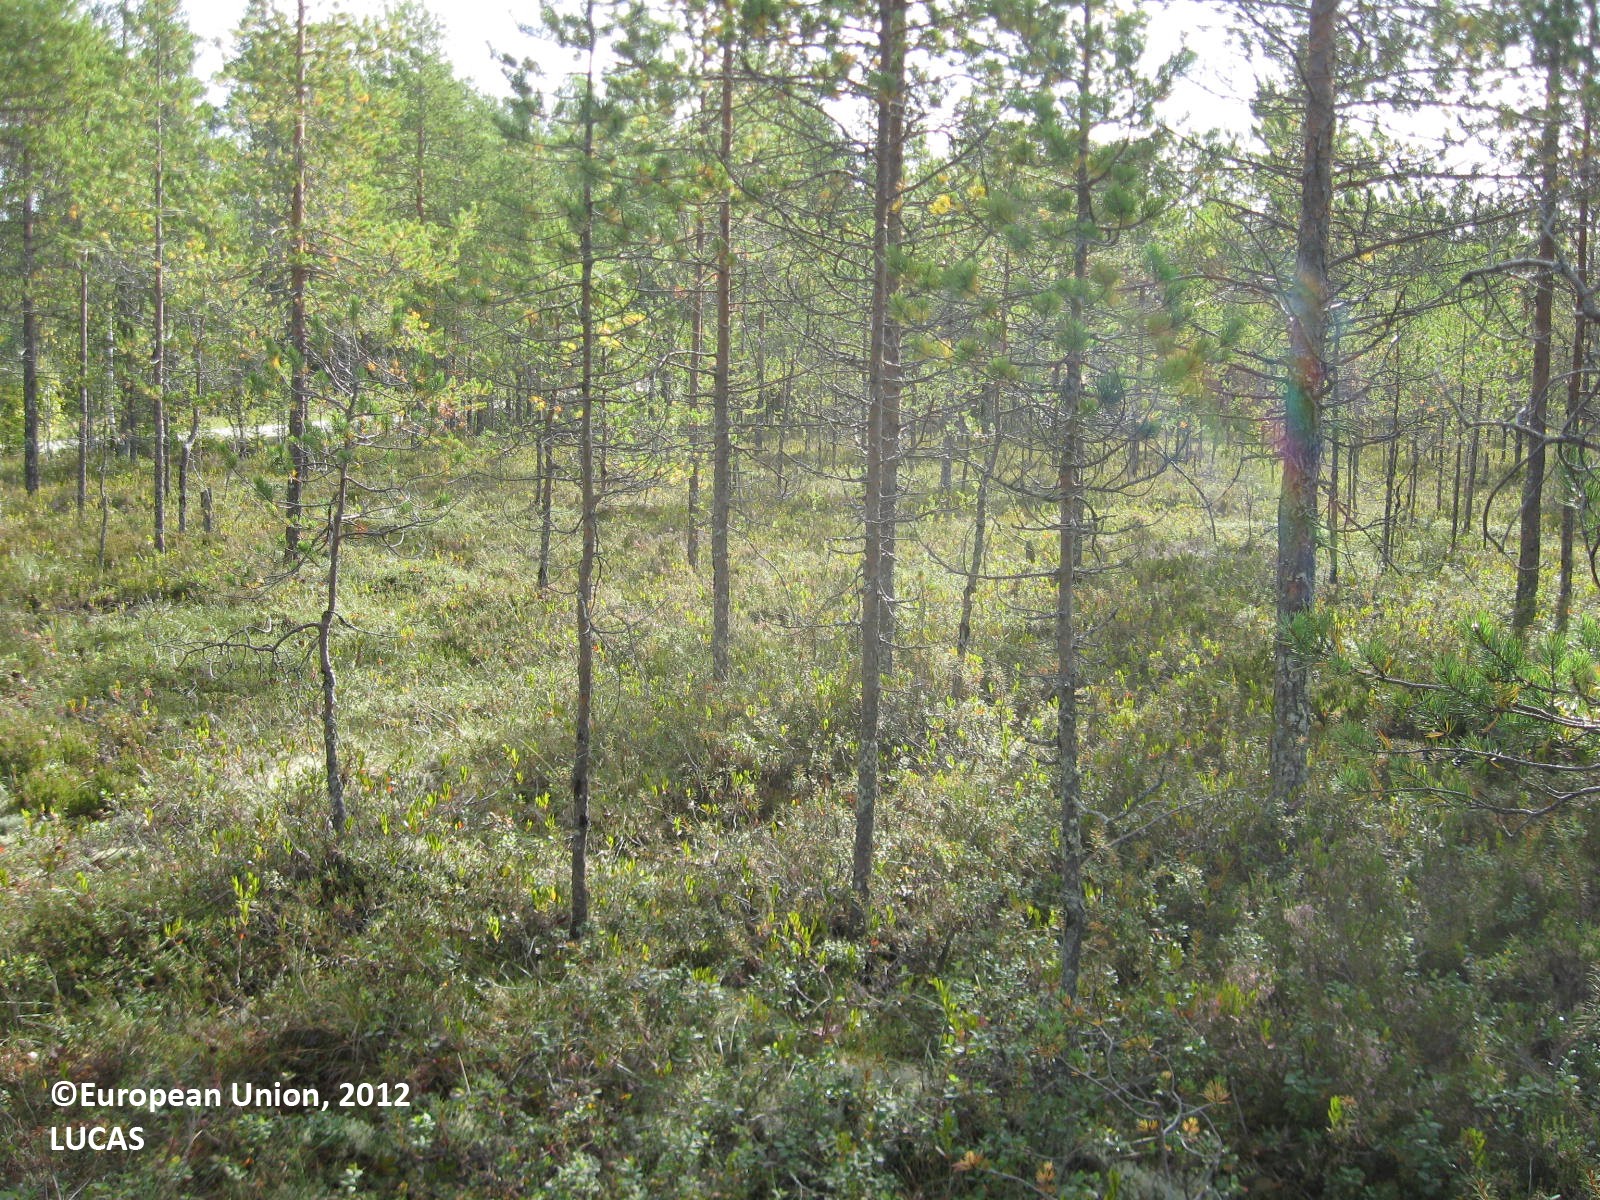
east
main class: Woodland
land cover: Pine dominated coniferous woodland
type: boreal forest
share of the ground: 25 - 50 %
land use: Forestry
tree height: > 5 m
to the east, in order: Pine dominated coniferous woodland; Ditches and canals; Pine dominated coniferous woodland; Ditches and canals; Abandoned hedges; Grass margins; Paved roads, cycling and walking lanes; Grass margins; Ditches and canals; Other mixed woodland; Grass margins; Paved roads, cycling and walking lanes; Grass margins; Ditches and canals; Other mixed woodland; Pine dominated mixed woodland; Pine dominated coniferous woodland; Spruce dominated coniferous woodland; Pine dominated coniferous woodland
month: August
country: FI
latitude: 63.5965
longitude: 29.5157
